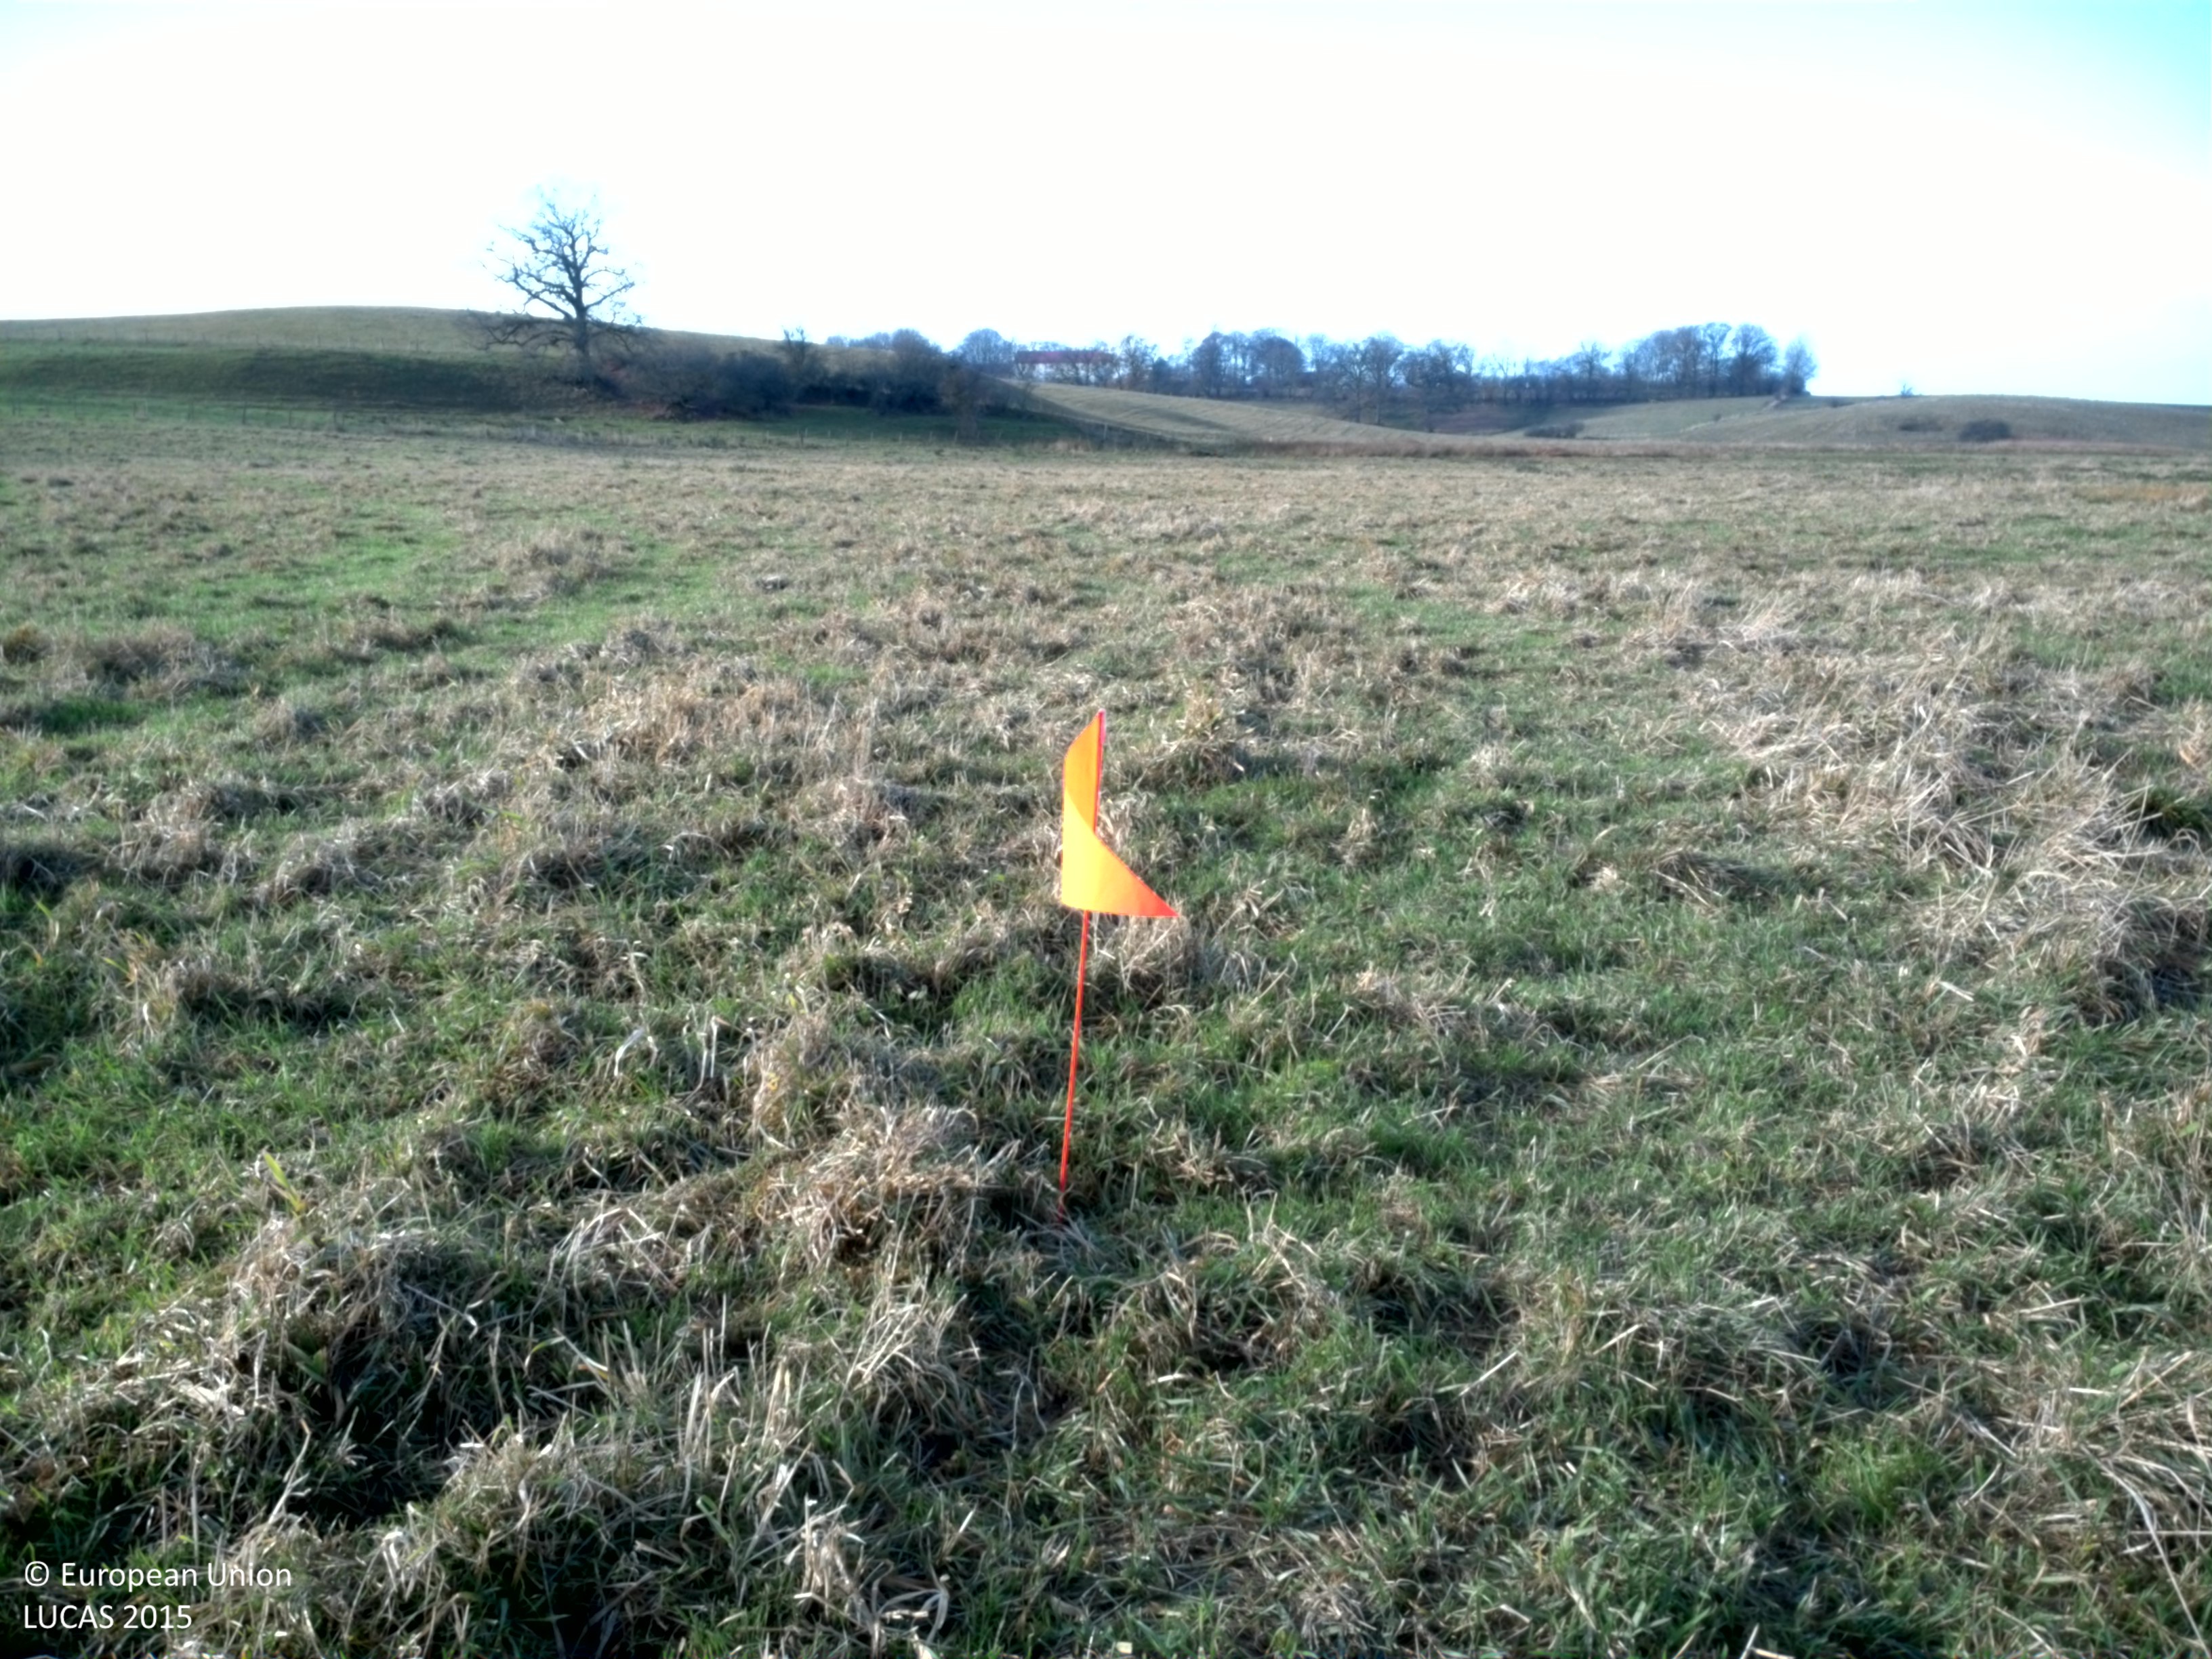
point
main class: Grassland
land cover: Grassland without tree/shrub cover
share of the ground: > 75 %
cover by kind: herbaceous plants 100 %
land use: Agriculture (excluding fallow land and kitchen gardens)
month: November
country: SE
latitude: 56.1510
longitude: 13.0721
